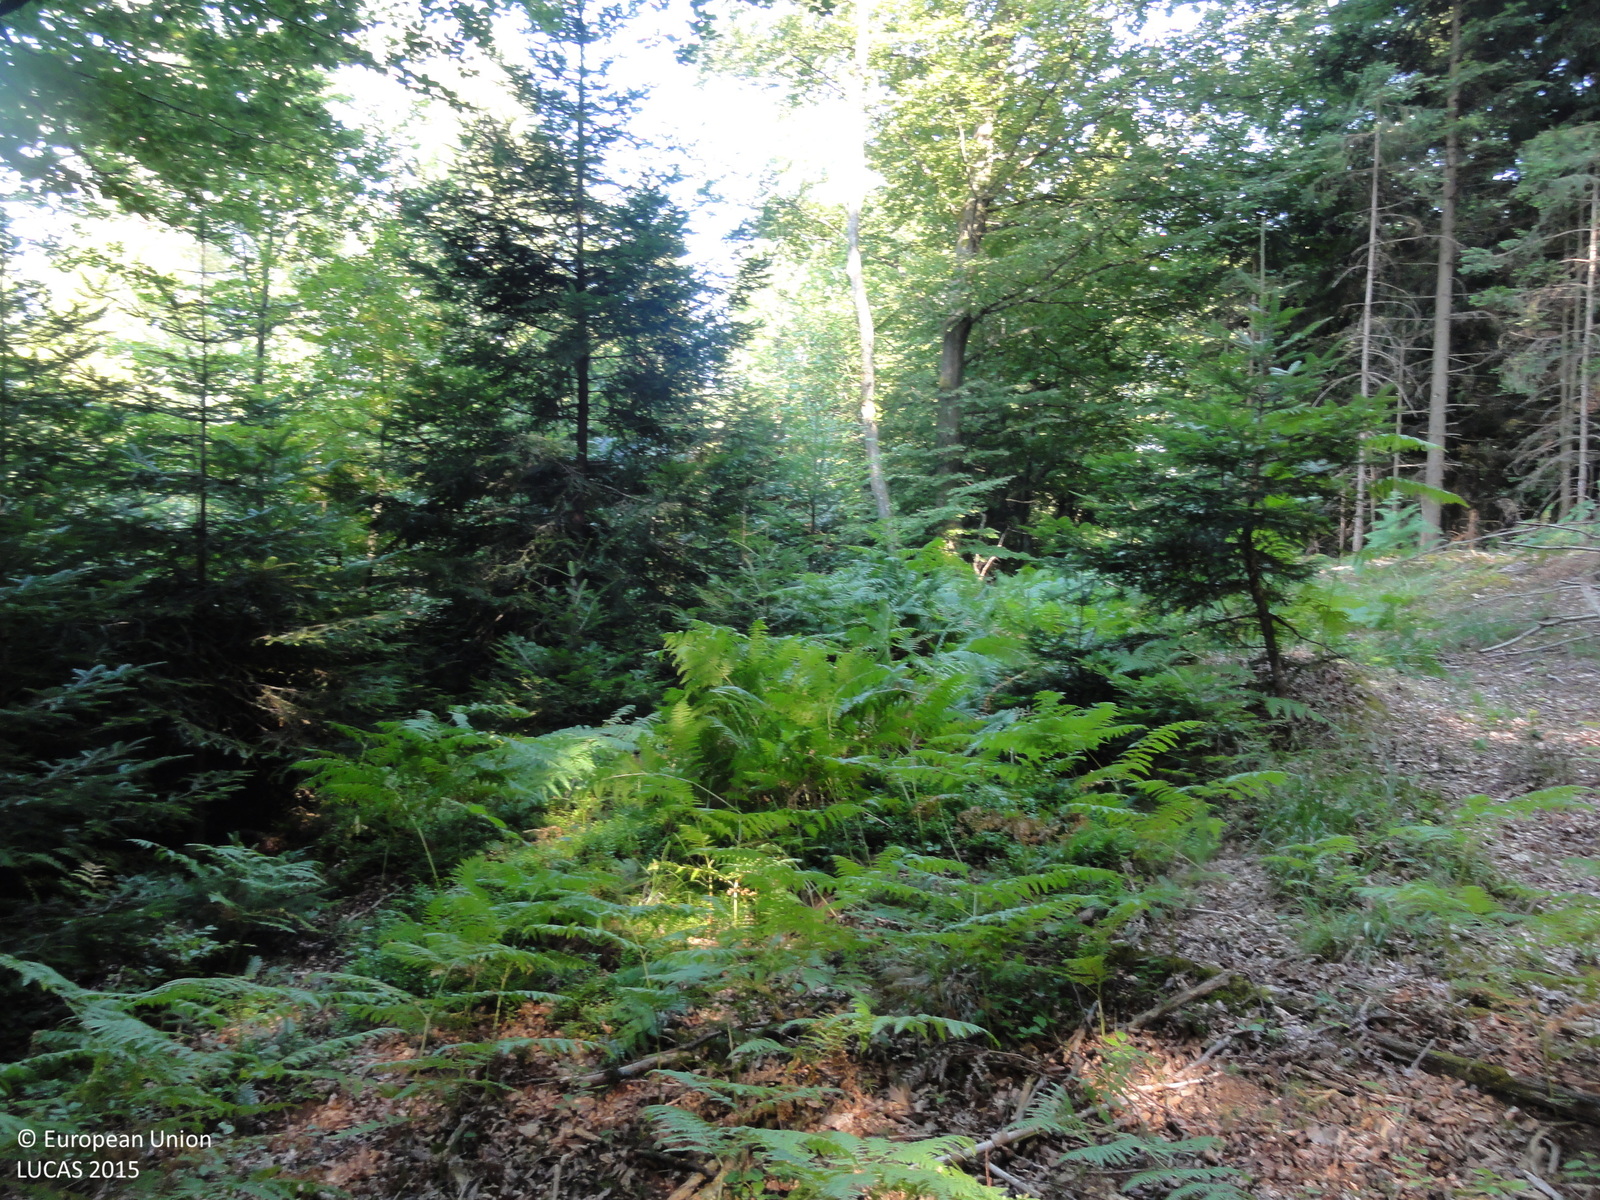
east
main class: Woodland
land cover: Spruce dominated mixed woodland
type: hemiboreal forest and nemoral coniferous forest and mixed broadleaved-coniferous forest
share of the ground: > 75 %
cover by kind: coniferous forest trees 40 %, broadleaved forest trees 40 %, shrubs 10 %, herbaceous plants 10 %
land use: Forestry
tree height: > 5 m
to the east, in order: Spruce dominated mixed woodland; Tracks; Spruce dominated mixed woodland; Shrubland with sparse tree cover; Tracks; Spontaneously vegetated surfaces; Broadleaved woodland; Spontaneously vegetated surfaces; Spruce dominated mixed woodland; Tracks; Spruce dominated mixed woodland
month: July
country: SI
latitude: 45.9173
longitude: 14.8314
